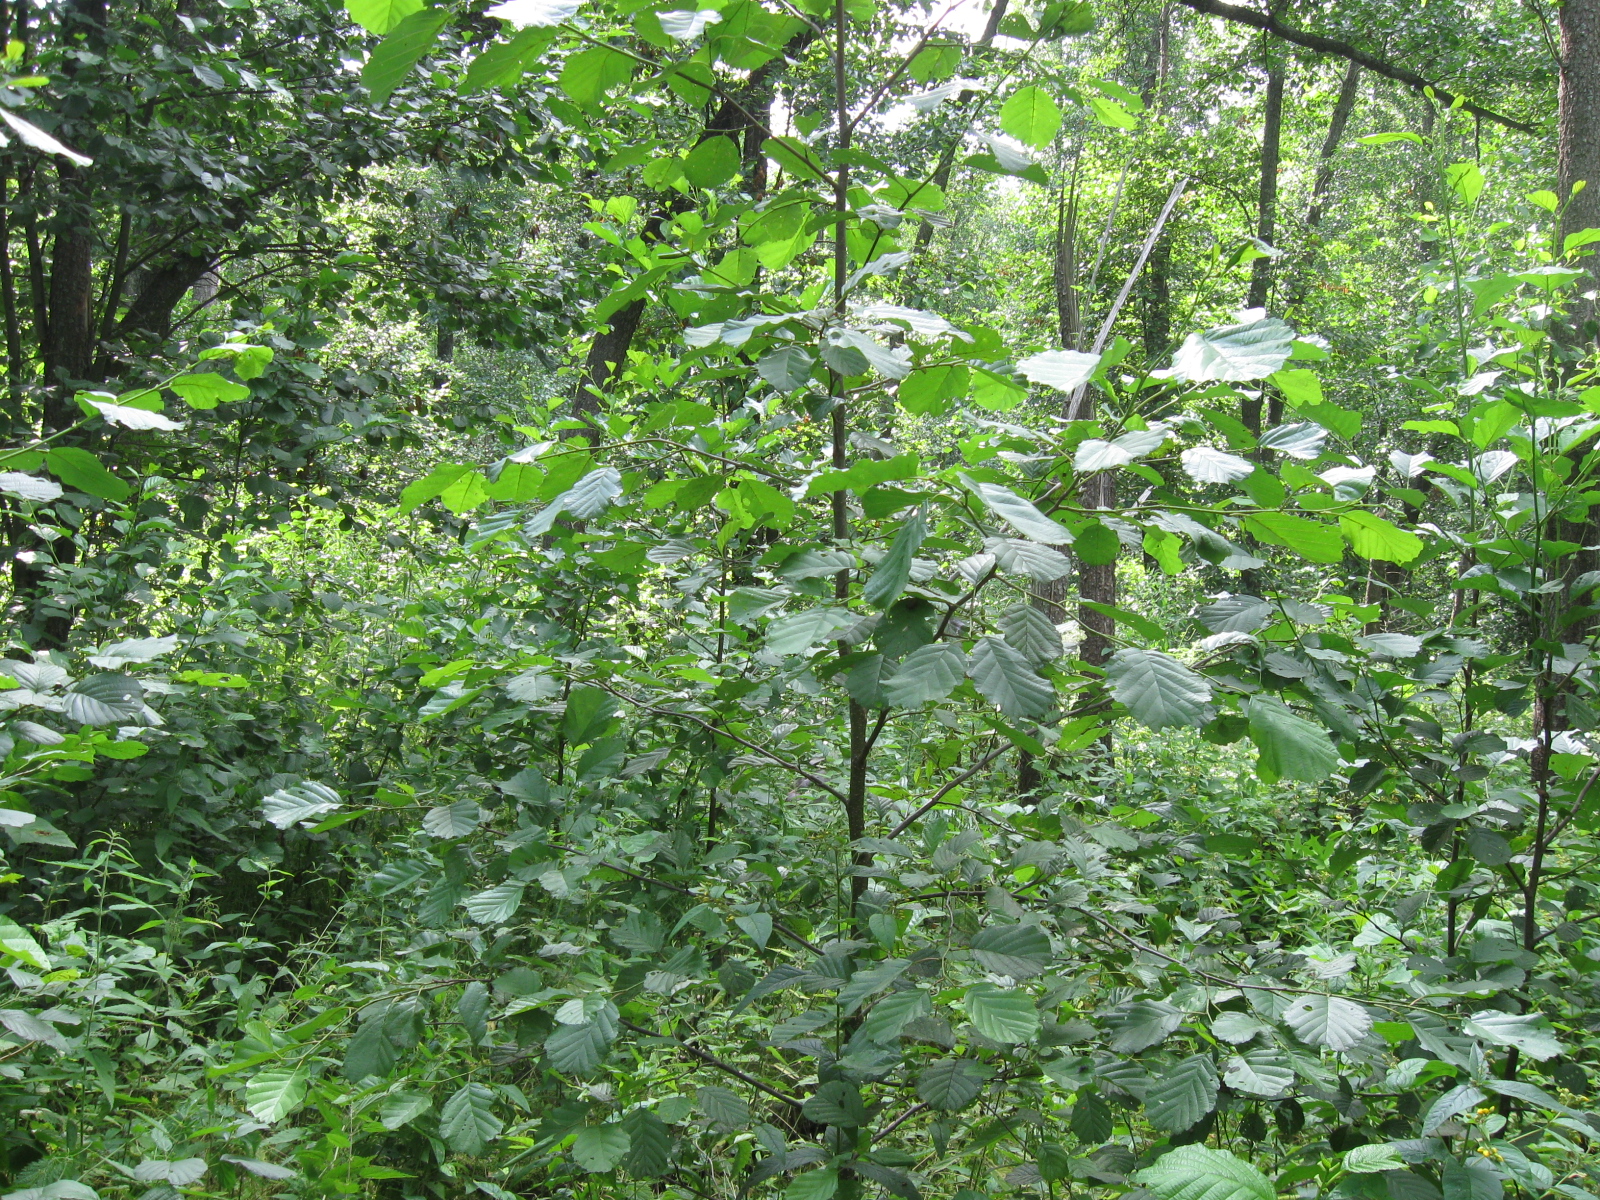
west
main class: Woodland
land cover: Broadleaved woodland
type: mire and swamp forests
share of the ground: > 75 %
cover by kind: broadleaved forest trees 75 %, shrubs 20 %, herbaceous plants 5 %
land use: Forestry
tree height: > 5 m
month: July
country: LT
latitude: 54.5287
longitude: 24.3939
